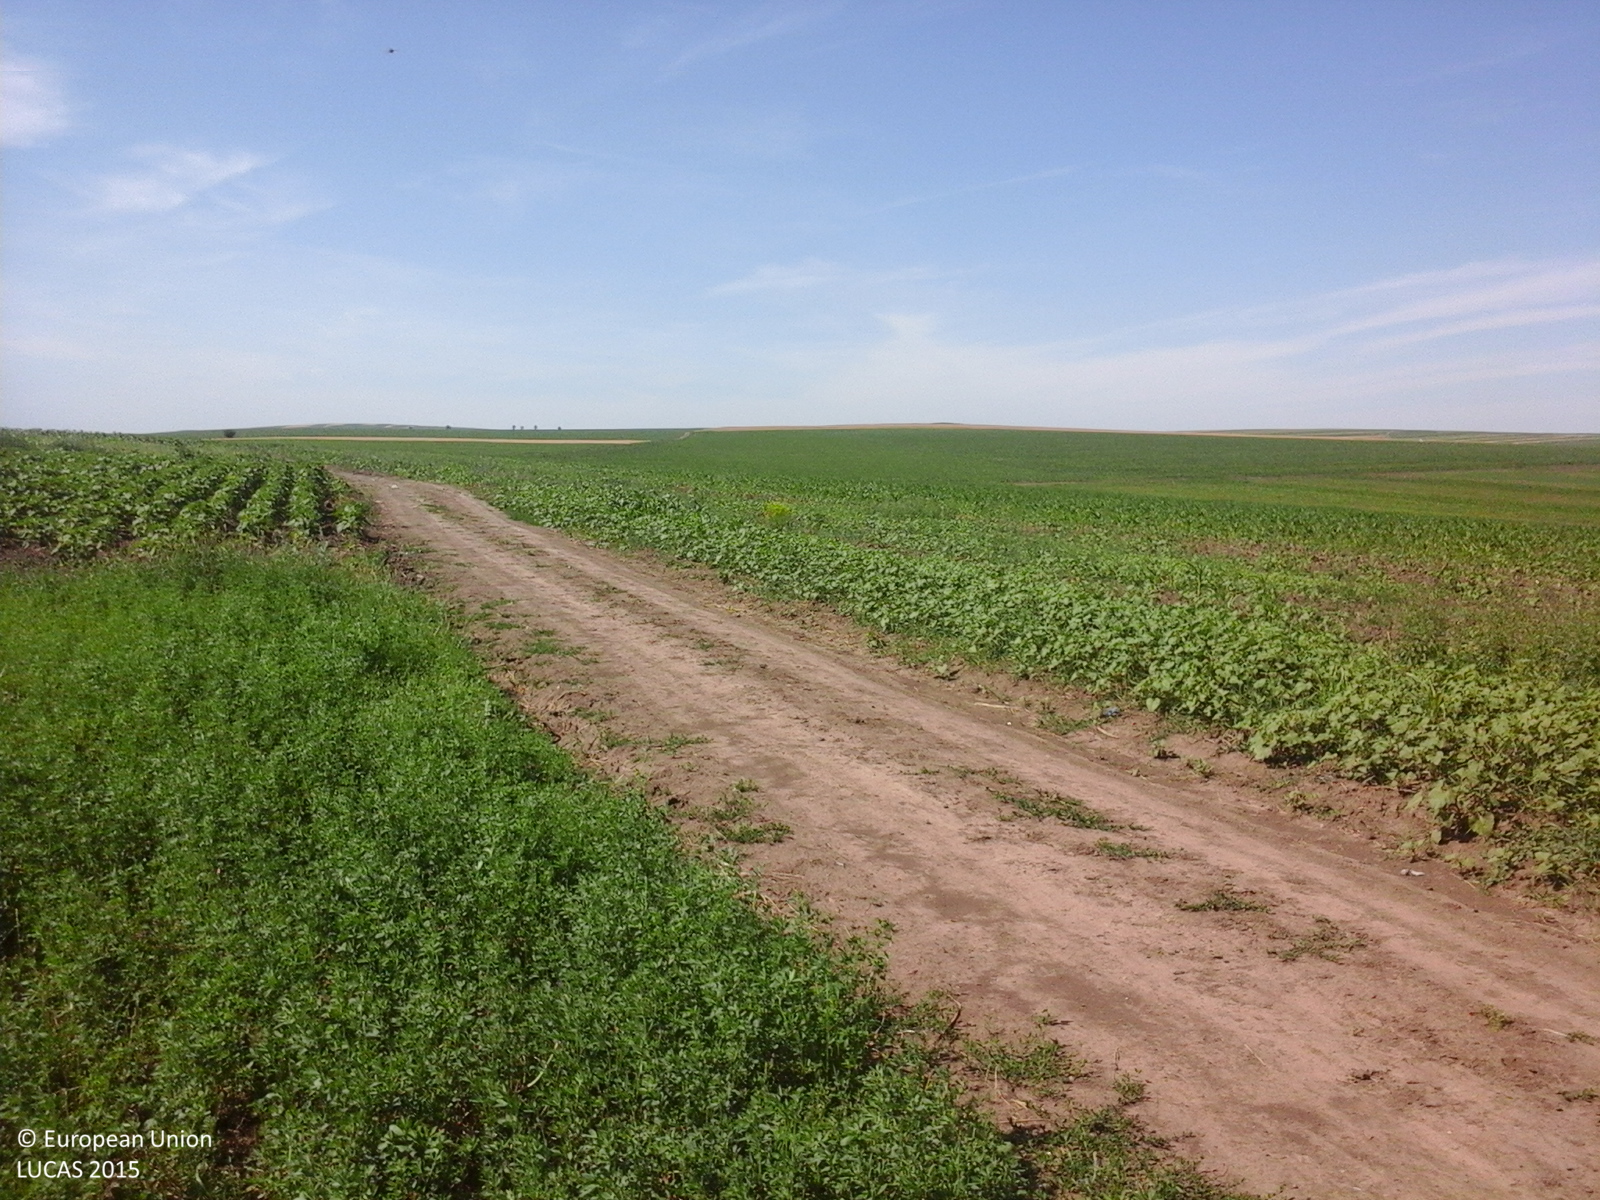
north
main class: Cropland
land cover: Lucerne
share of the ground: > 75 %
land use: Agriculture (excluding fallow land and kitchen gardens)
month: June
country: RO
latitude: 47.1299
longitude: 26.8791
